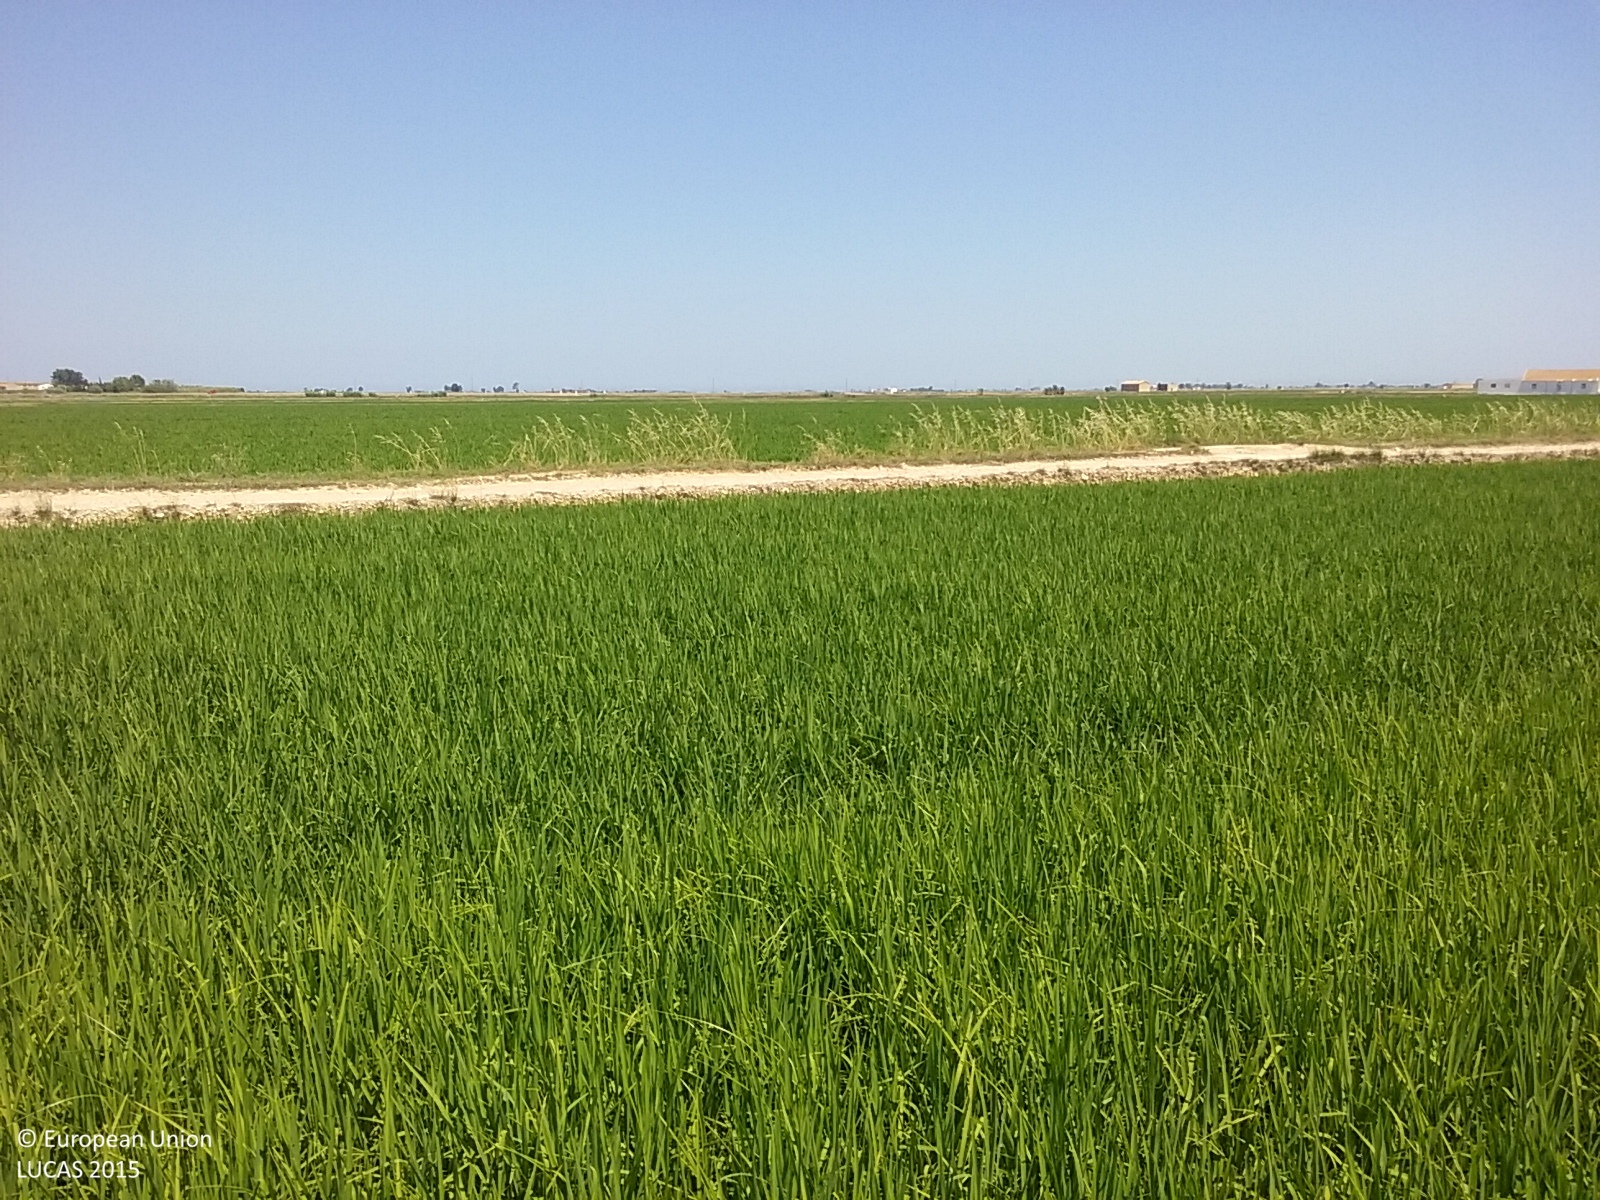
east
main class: Cropland
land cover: Rice
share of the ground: 50 - 75 %
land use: Agriculture (excluding fallow land and kitchen gardens)
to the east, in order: Other structural elements; Rice; Tracks; Grass margins; Rice; Other structural elements; Rice; Other structural elements; Rice; Other structural elements; Ditches and canals; Other structural elements; Rice; Other structural elements; Rice; Other structural elements; Rice
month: June
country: ES
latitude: 40.7682
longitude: 0.6711
